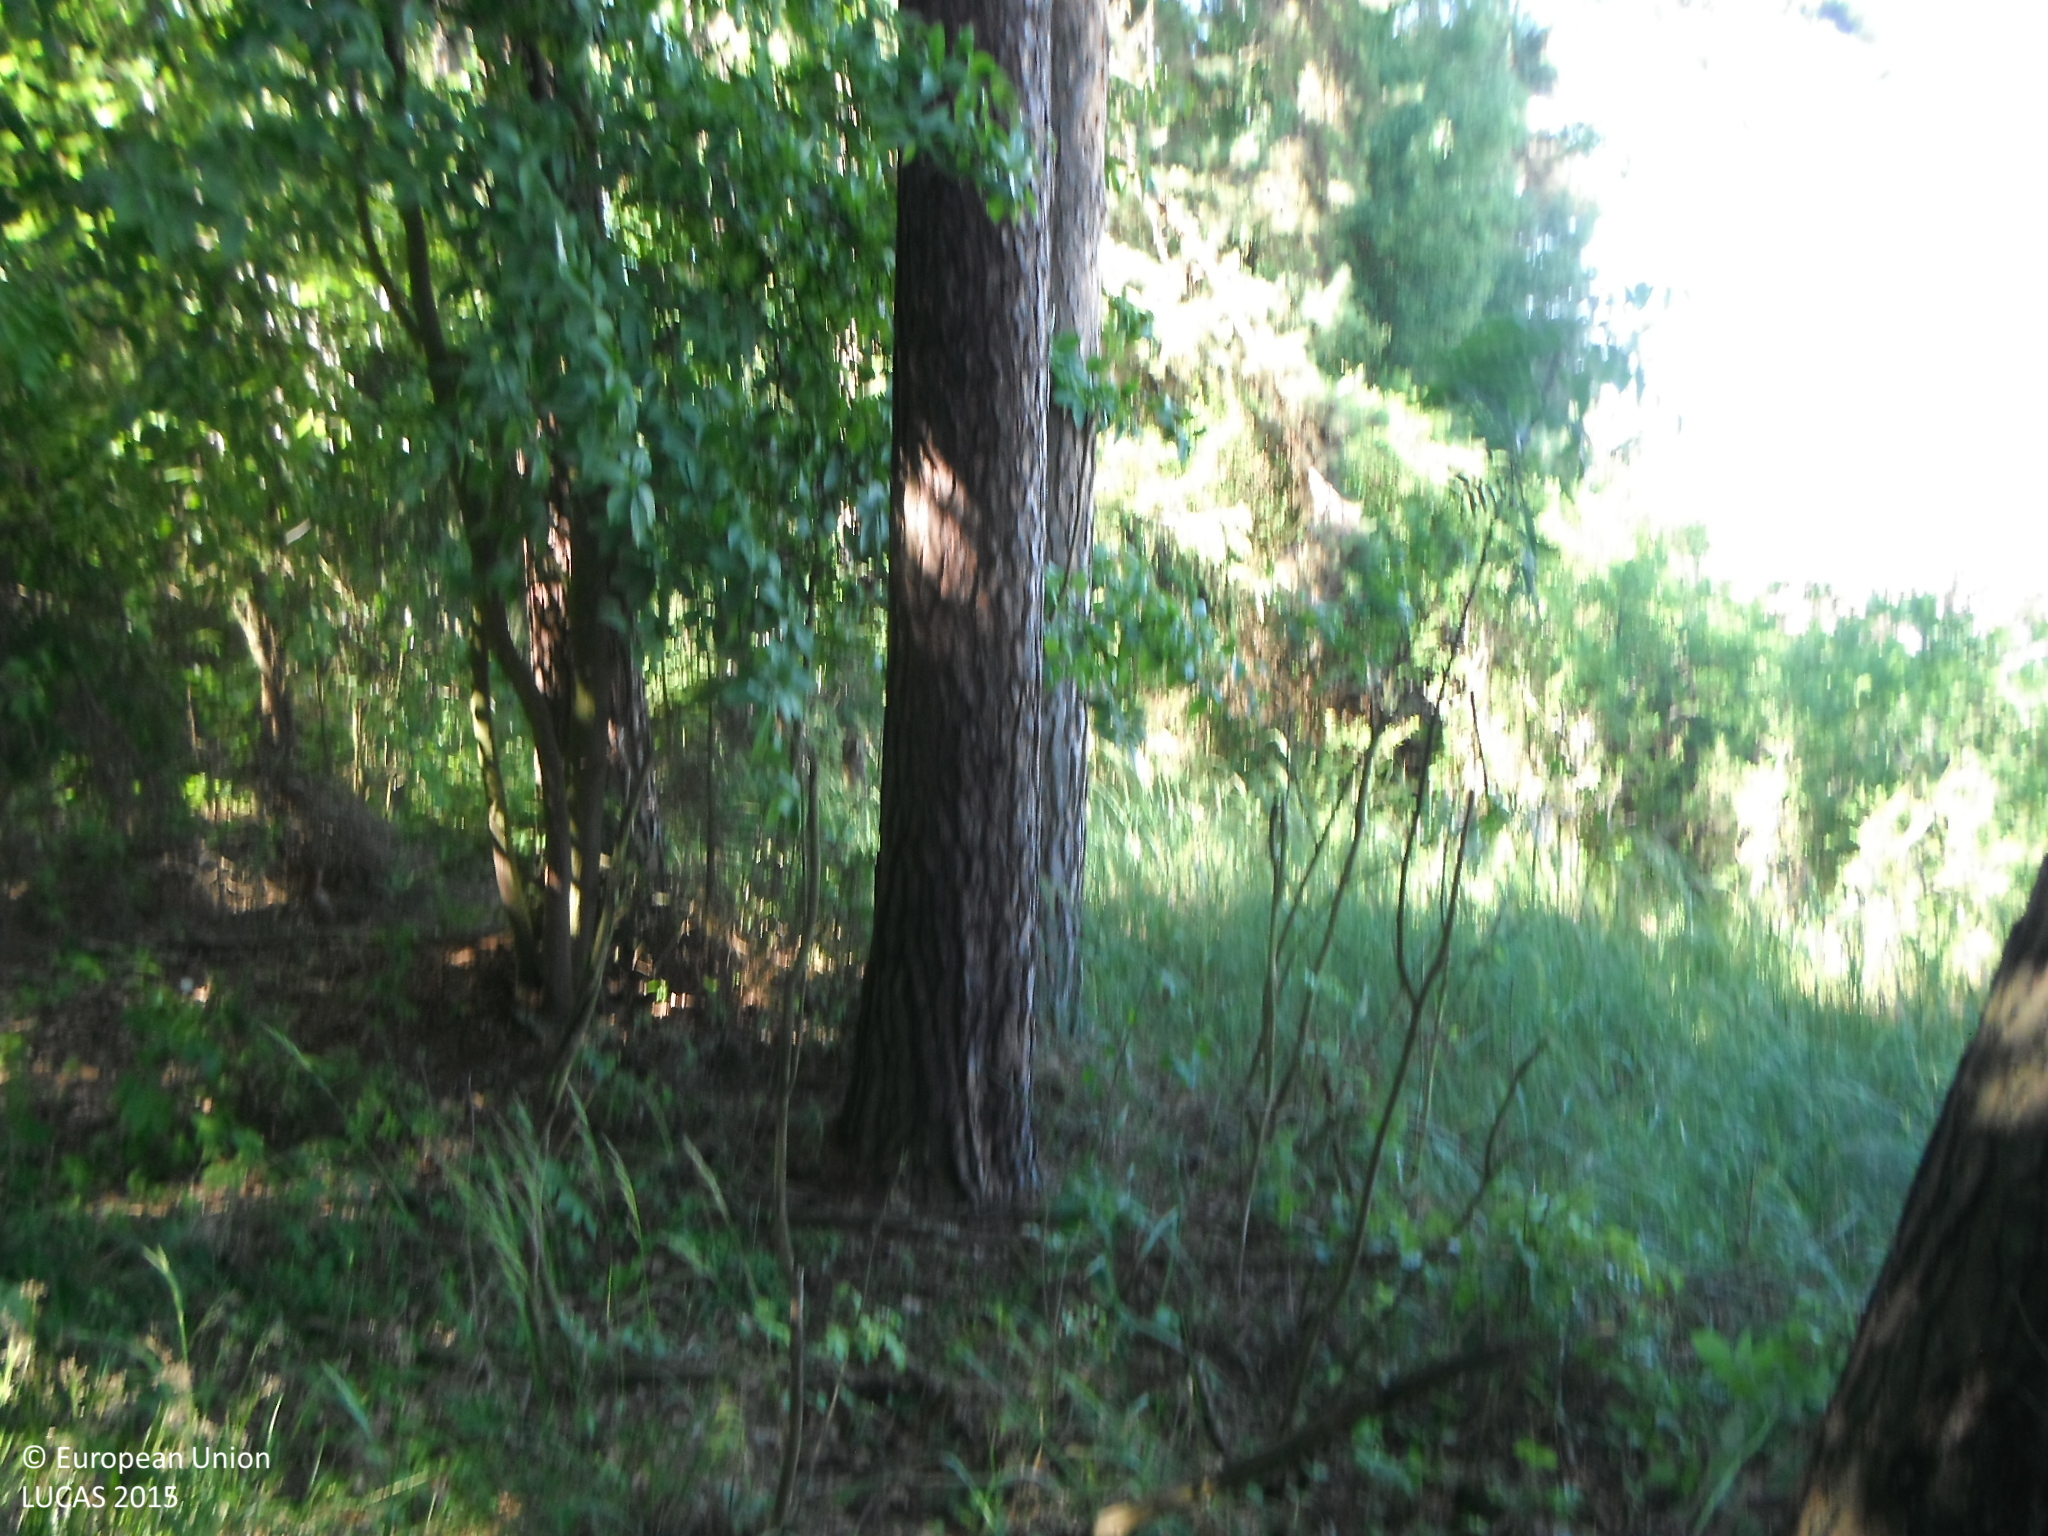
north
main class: Woodland
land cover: Other mixed woodland
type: hemiboreal forest and nemoral coniferous forest and mixed broadleaved-coniferous forest
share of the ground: > 75 %
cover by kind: broadleaved forest trees 55 %, coniferous forest trees 40 %, herbaceous plants 5 %
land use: Forestry
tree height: > 5 m
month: July
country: SK
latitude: 48.9353
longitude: 20.6997
